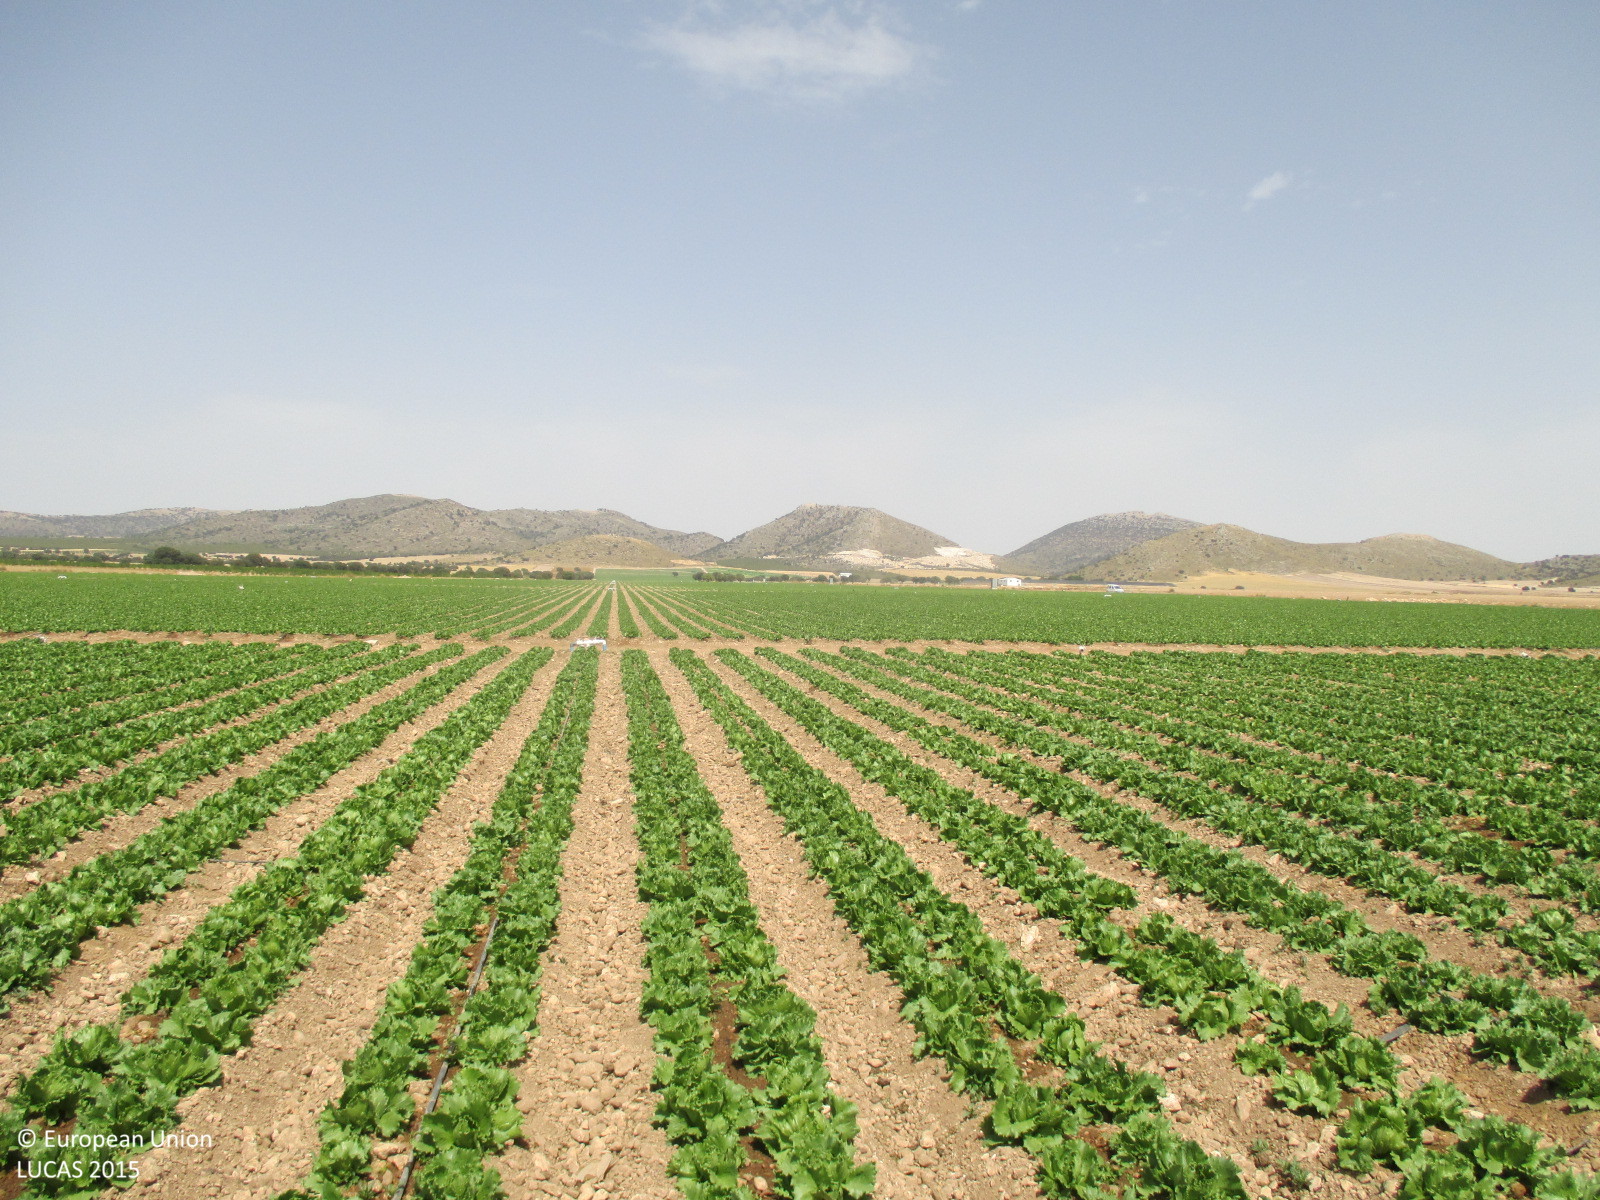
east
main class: Cropland
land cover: Other fresh vegetables
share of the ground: < 10 %
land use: Agriculture (excluding fallow land and kitchen gardens)
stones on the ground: 10 - 25 %
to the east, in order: Other fresh vegetables; Tracks; Other fresh vegetables; Tracks; Other fresh vegetables
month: July
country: ES
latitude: 37.8977
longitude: -2.3055
